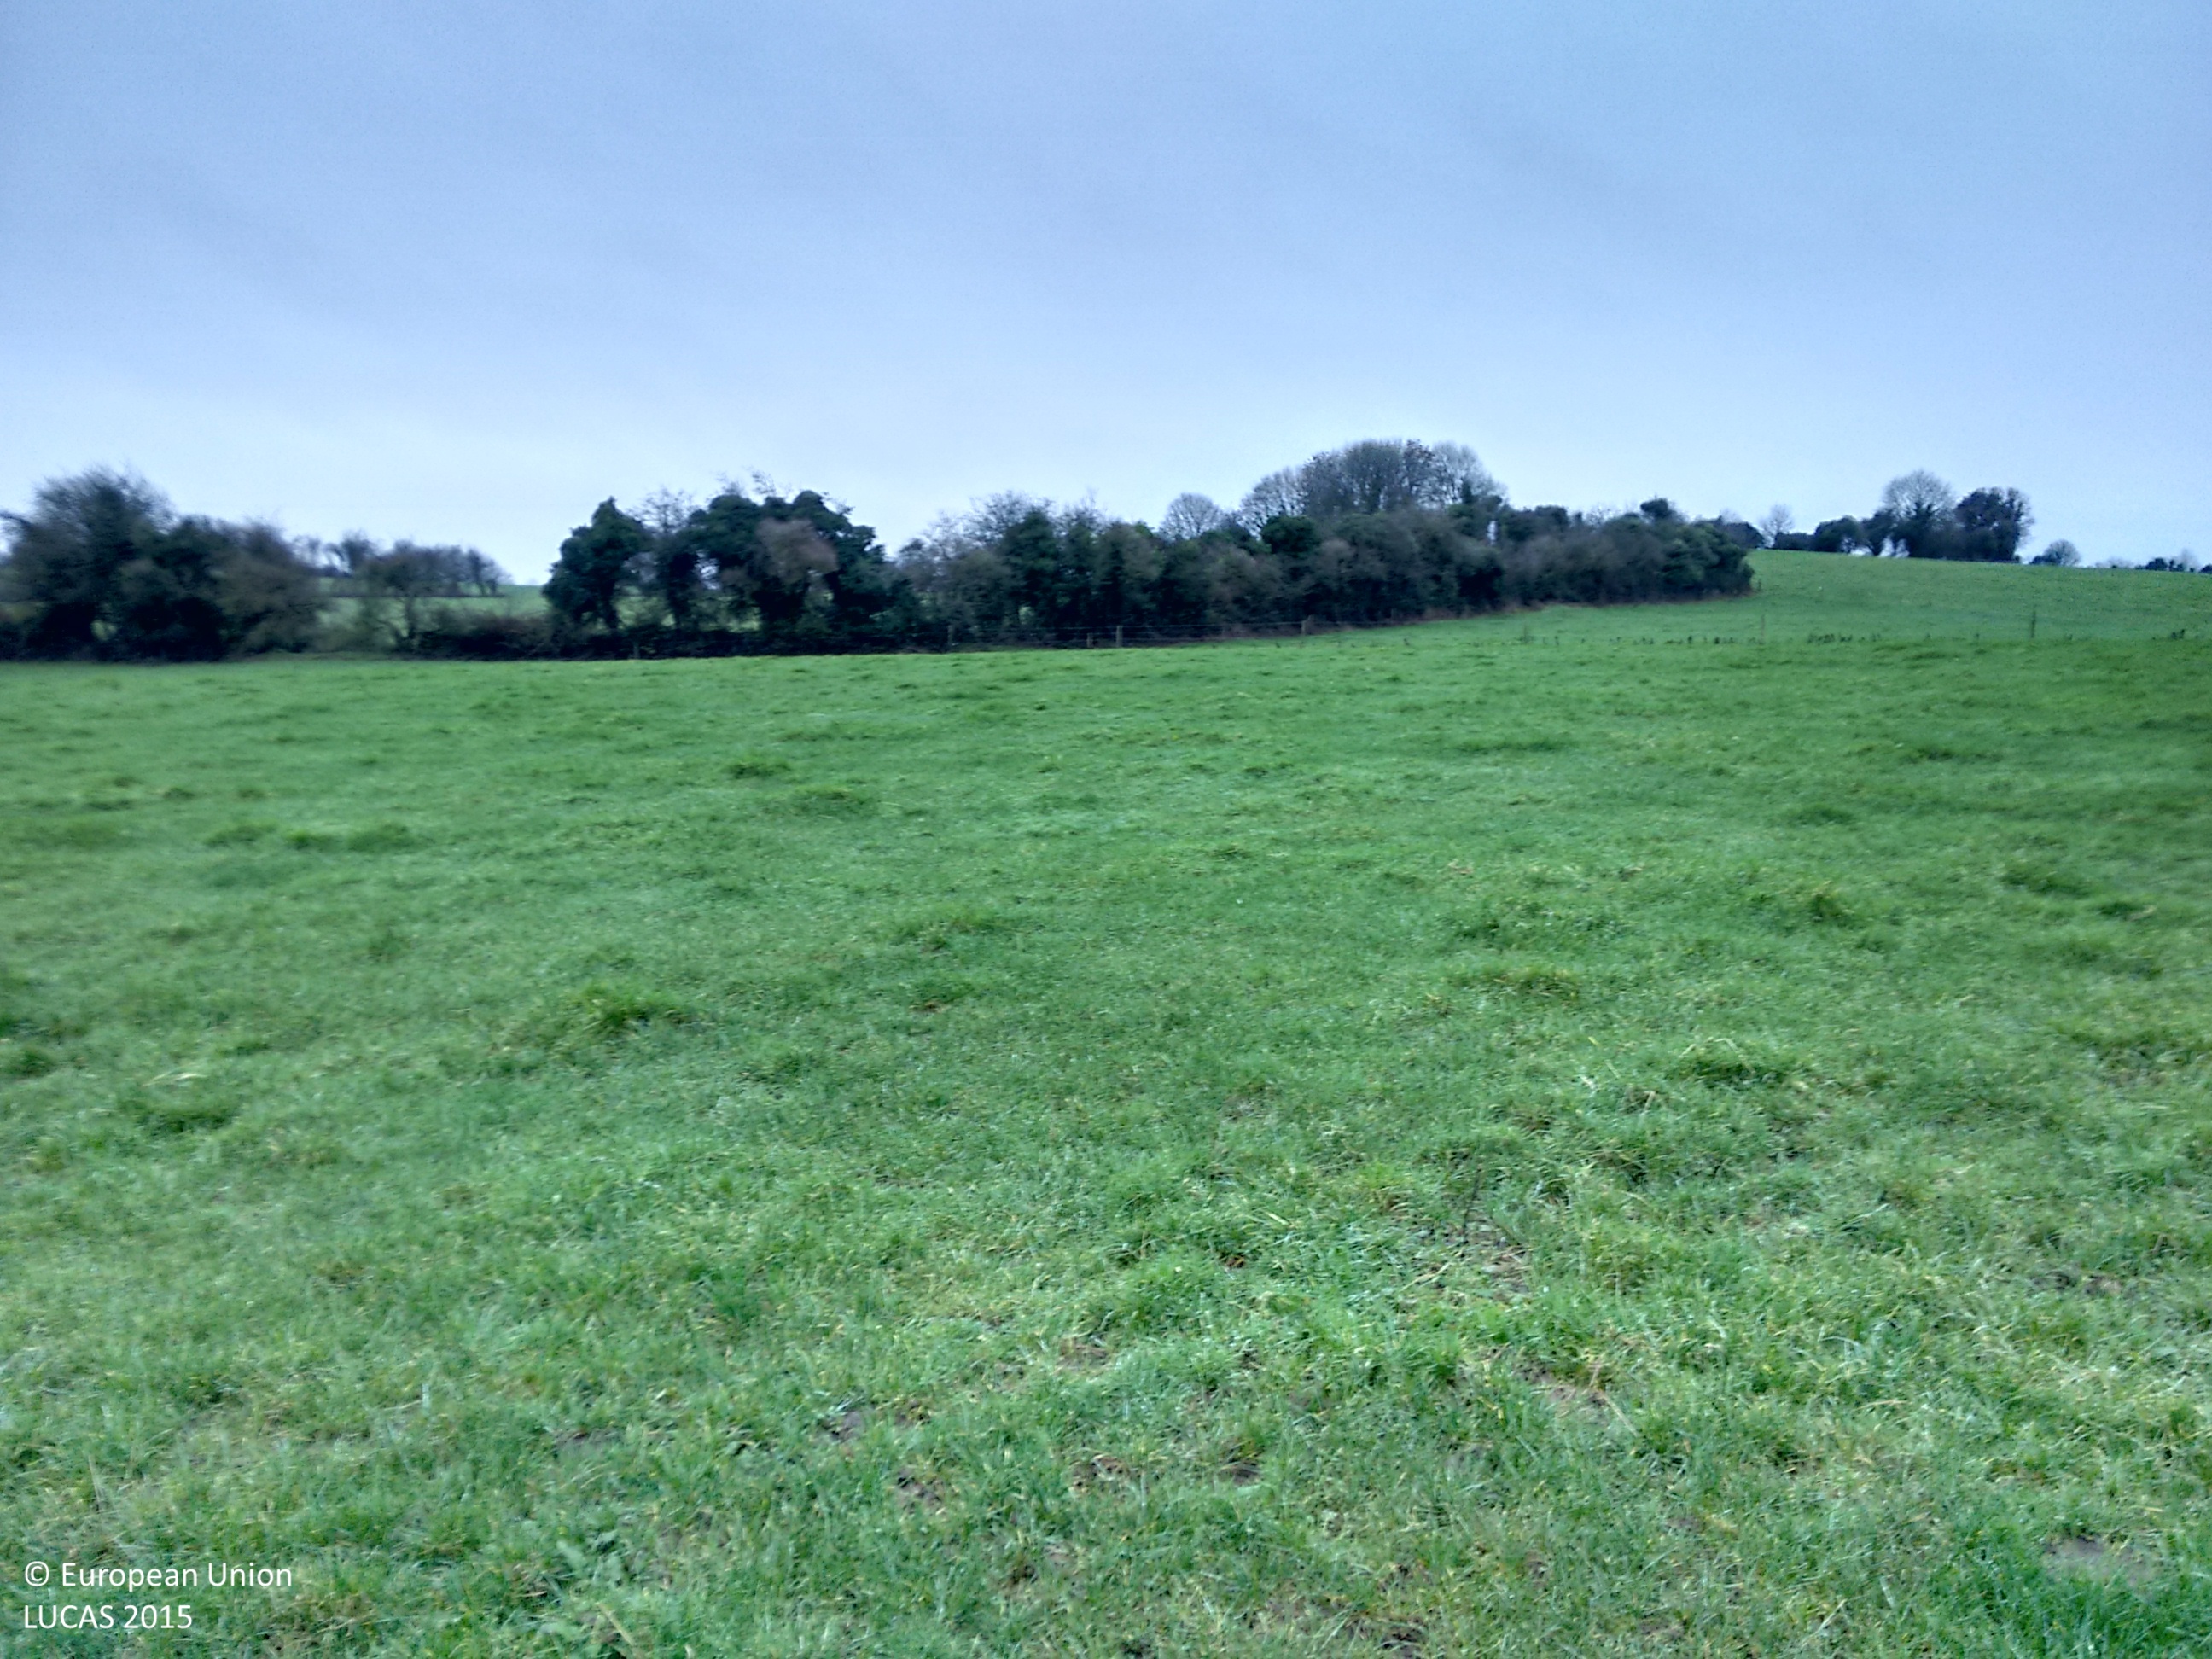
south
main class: Grassland
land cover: Grassland without tree/shrub cover
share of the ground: > 75 %
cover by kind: herbaceous plants 95 %, unconsolidated bare surface 5 %
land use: Agriculture (excluding fallow land and kitchen gardens)
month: December
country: IE
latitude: 53.5199
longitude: -7.5810
